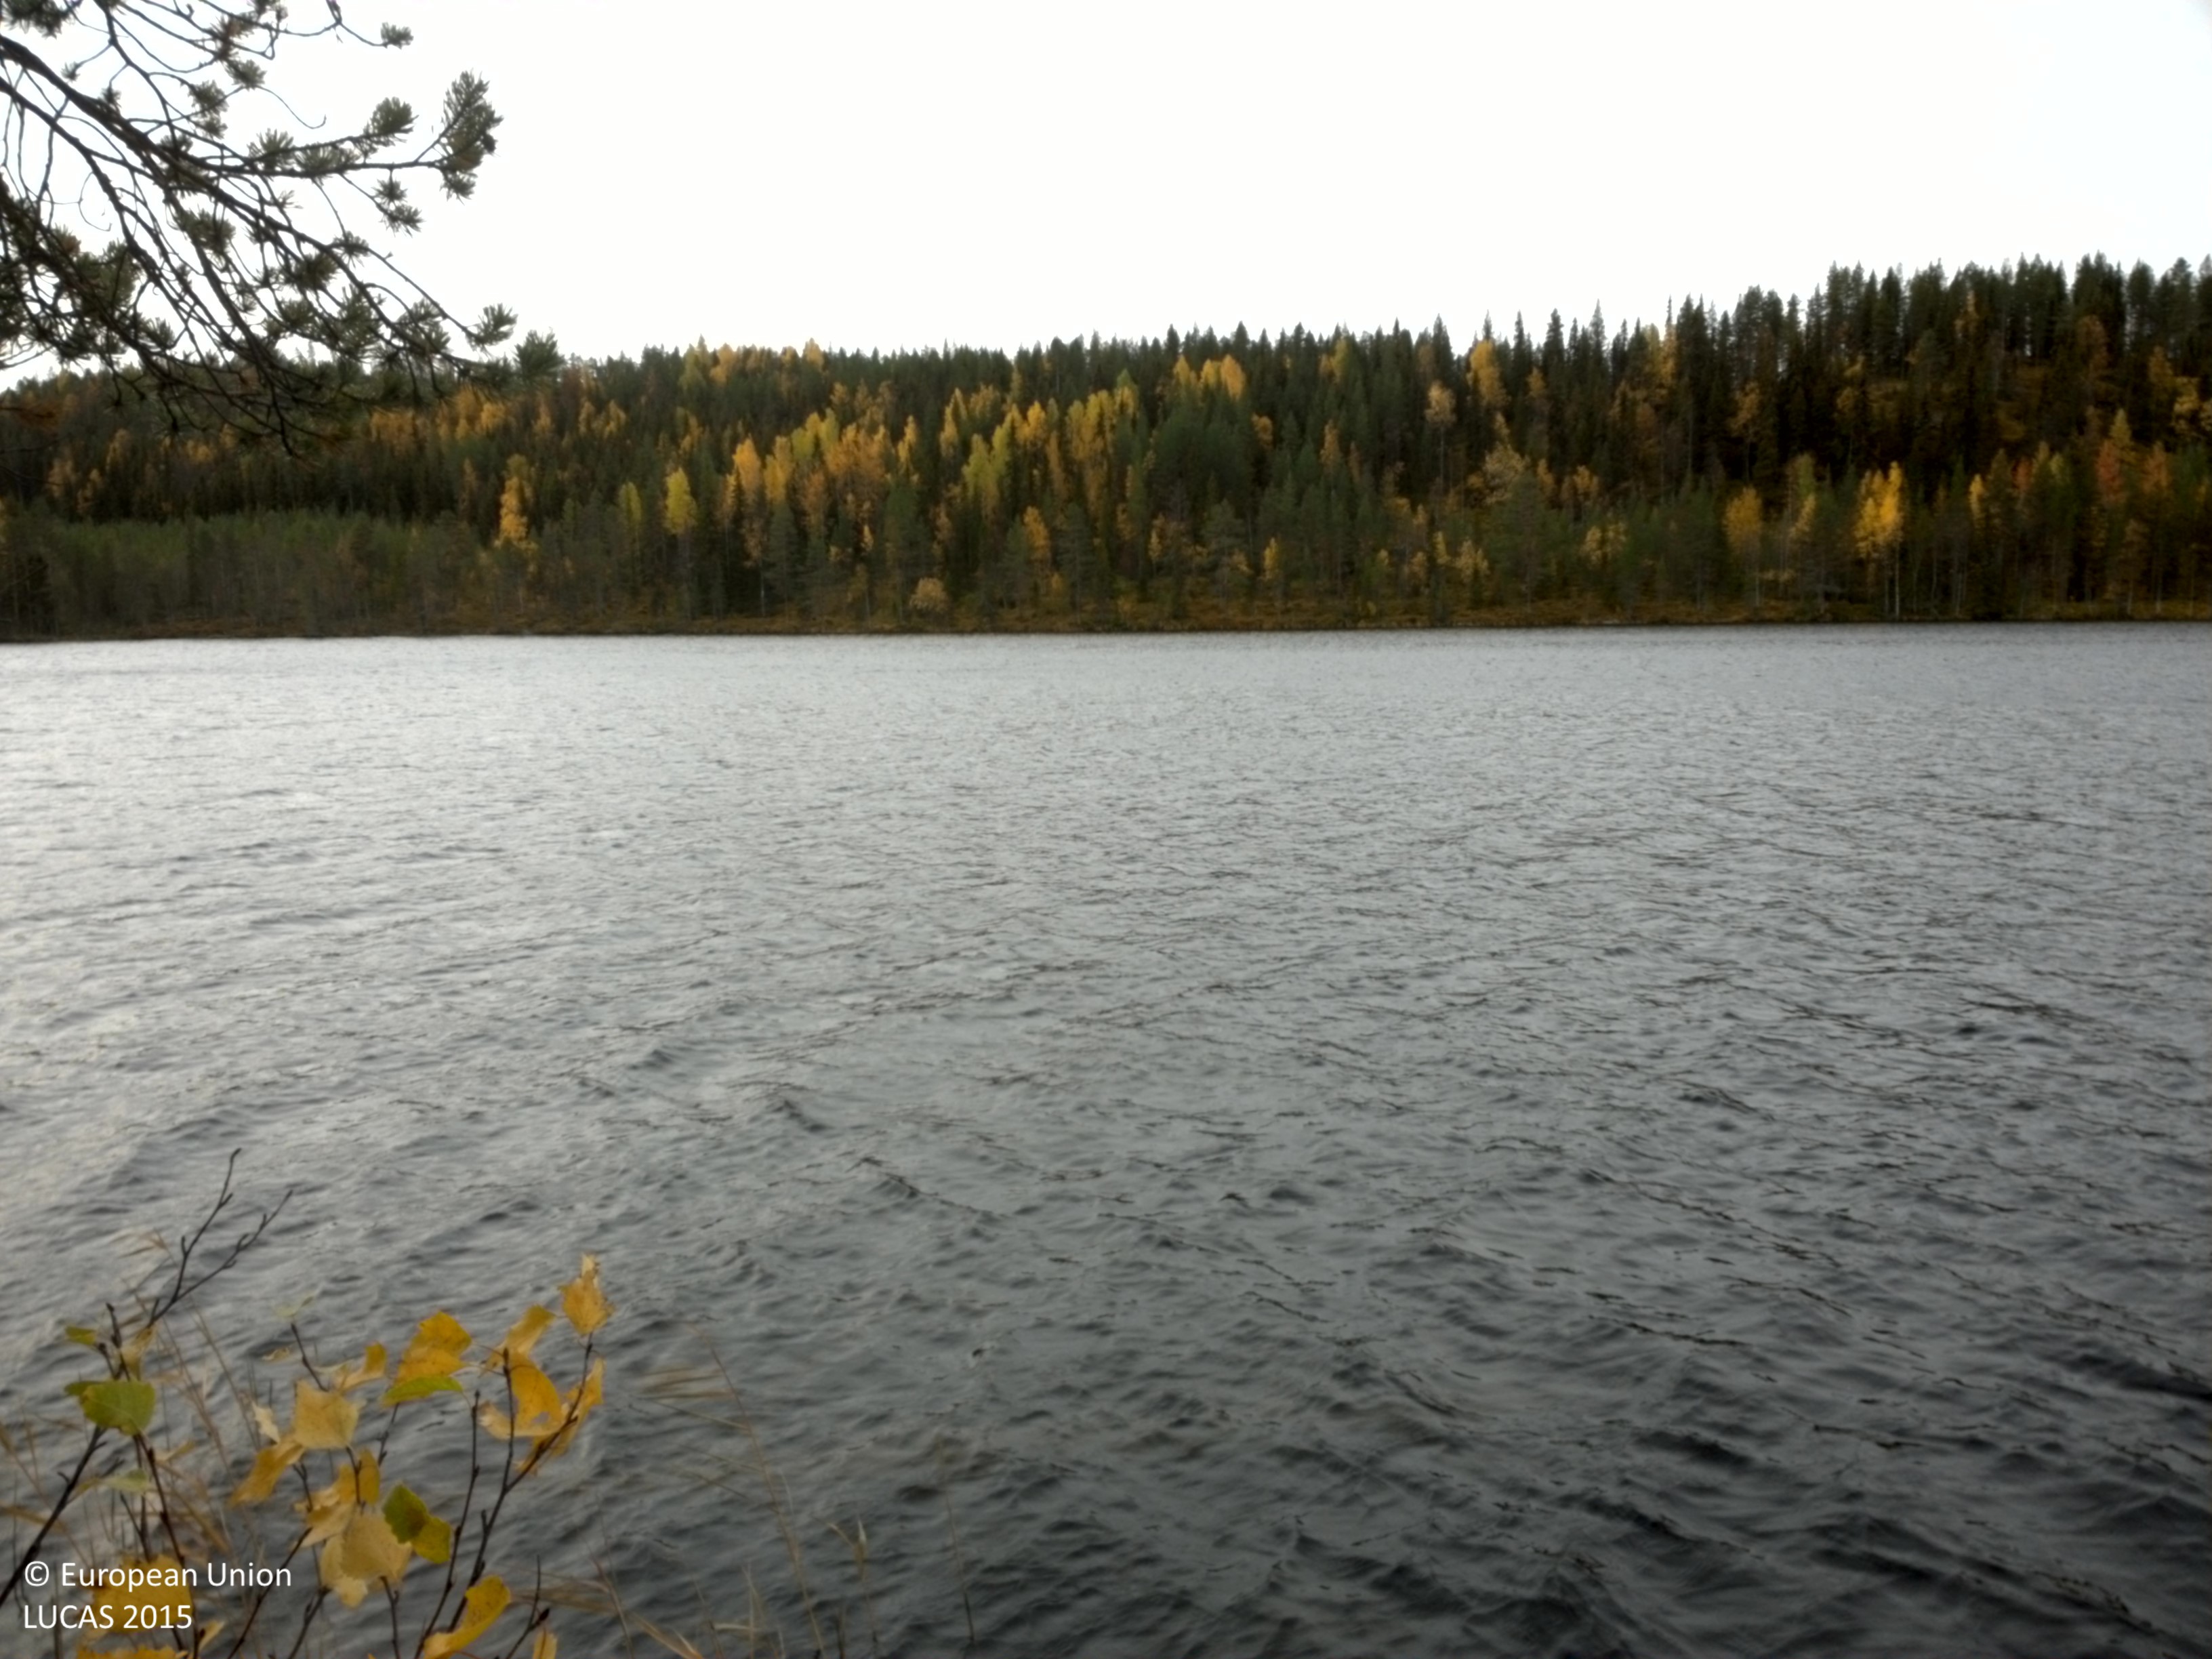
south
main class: Woodland
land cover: Pine dominated coniferous woodland
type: boreal forest
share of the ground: 25 - 50 %
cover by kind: shrubs 45 %, coniferous forest trees 40 %, lichens and mosses 10 %, broadleaved forest trees 5 %
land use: Forestry
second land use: Residential
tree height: > 5 m
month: October
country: SE
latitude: 65.0576
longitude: 17.4653
